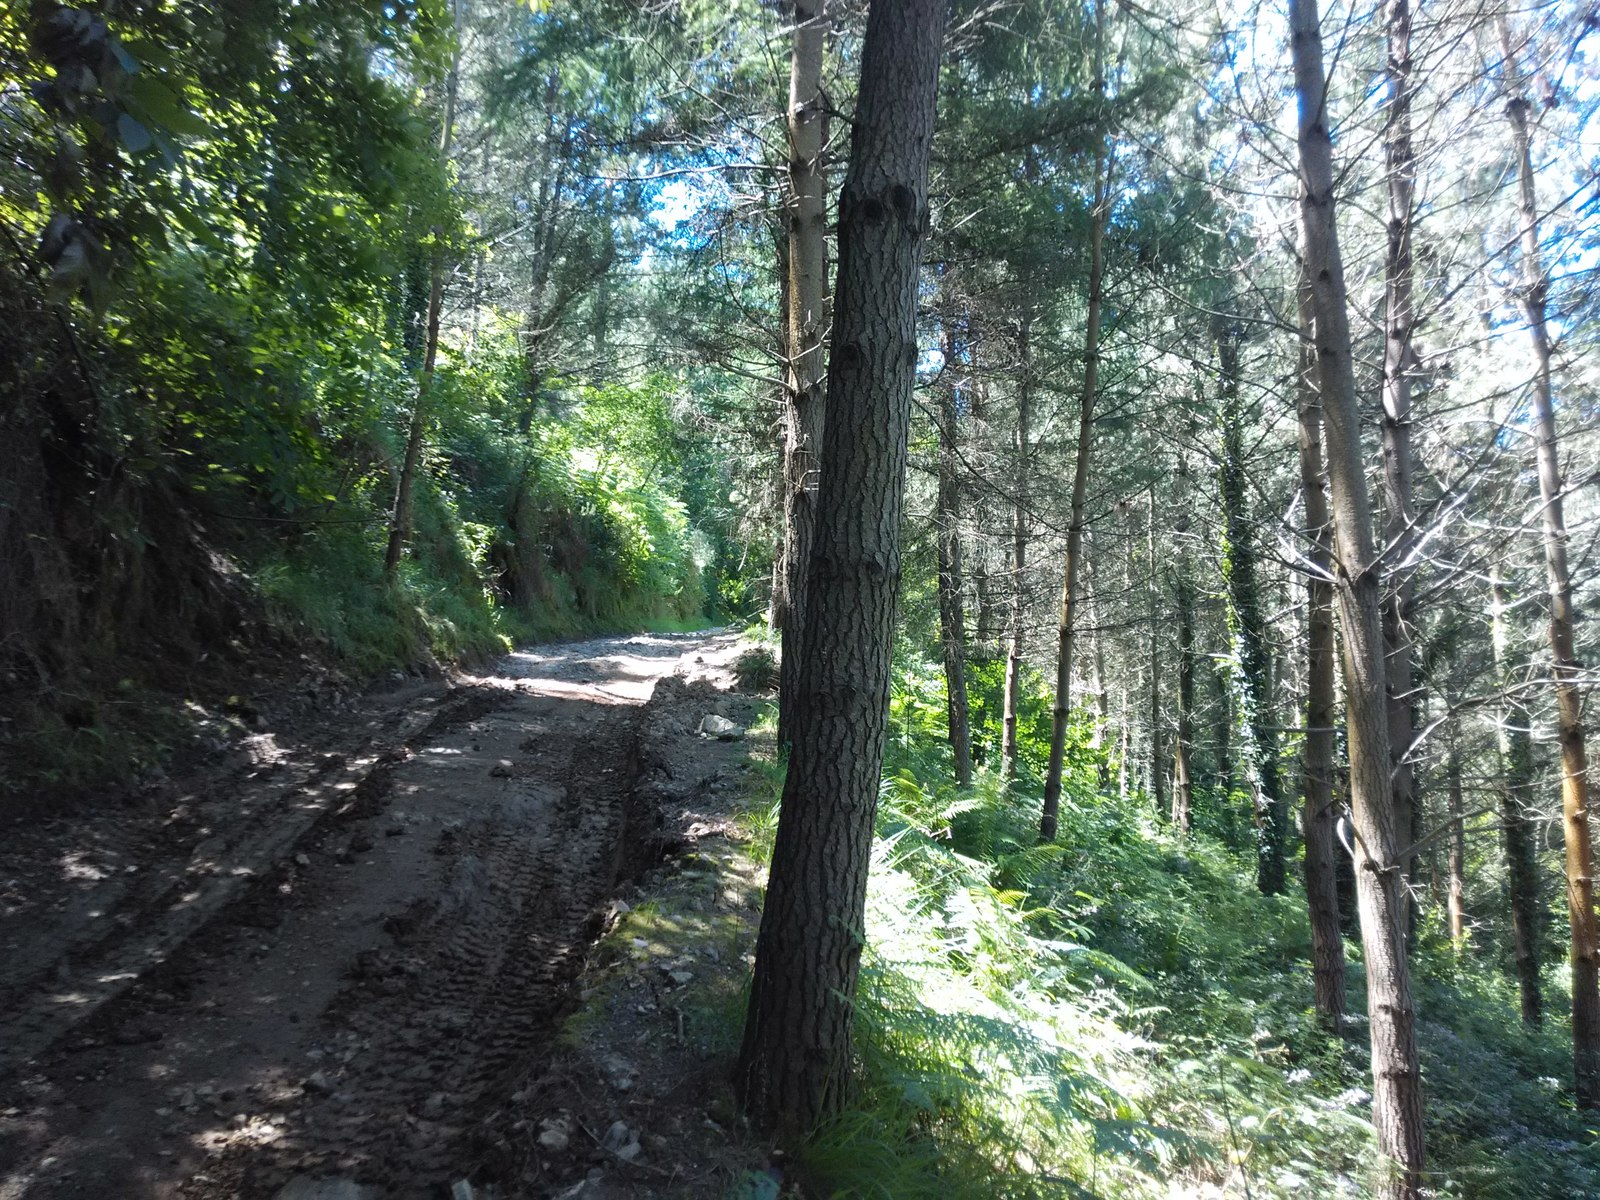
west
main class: Woodland
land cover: Pine dominated coniferous woodland
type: exotic forest
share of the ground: > 75 %
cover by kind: coniferous forest trees 95 %, shrubs 5 %
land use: Forestry
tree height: > 5 m
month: June
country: ES
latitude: 43.2001
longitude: -2.4197
